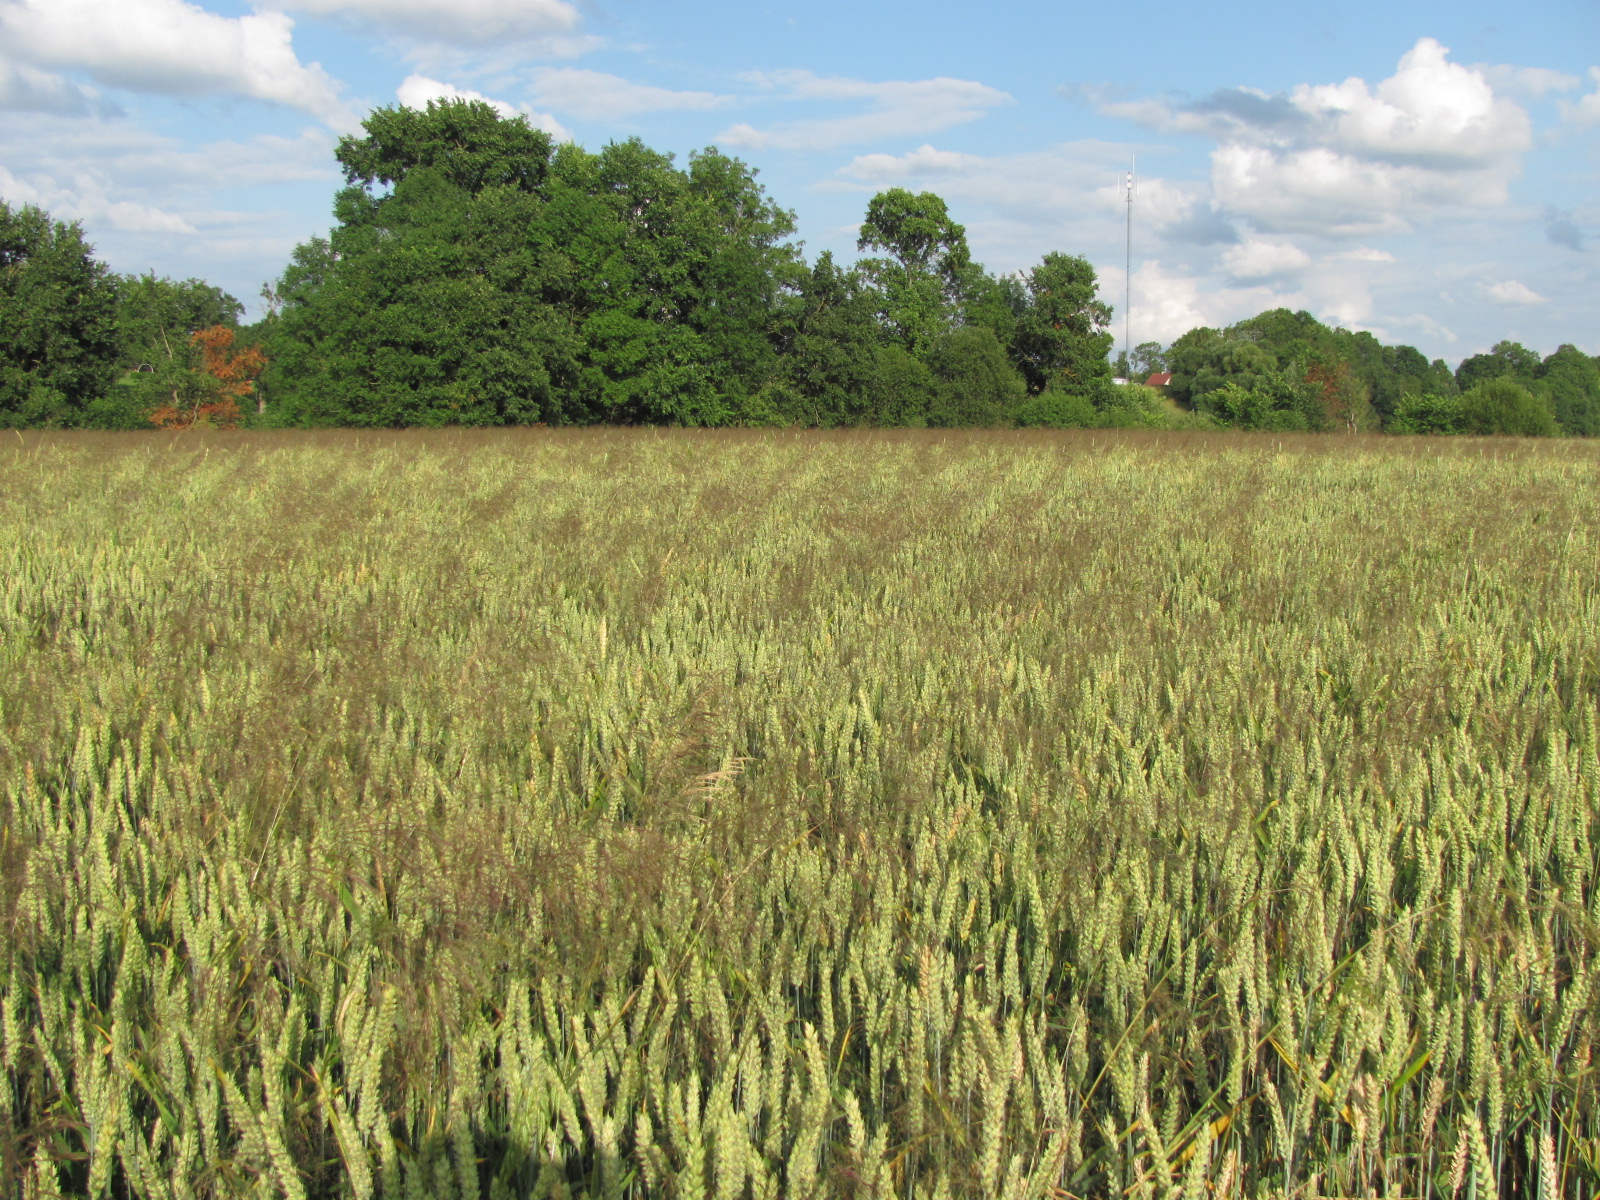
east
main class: Cropland
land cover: Common wheat
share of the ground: > 75 %
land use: Agriculture (excluding fallow land and kitchen gardens)
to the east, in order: Common wheat; Broadleaved woodland; Grassland without tree/shrub cover; Inland marshes; Inland fresh running water; Inland marshes; Grassland without tree/shrub cover
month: July
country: LV
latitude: 56.3561
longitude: 24.2522
